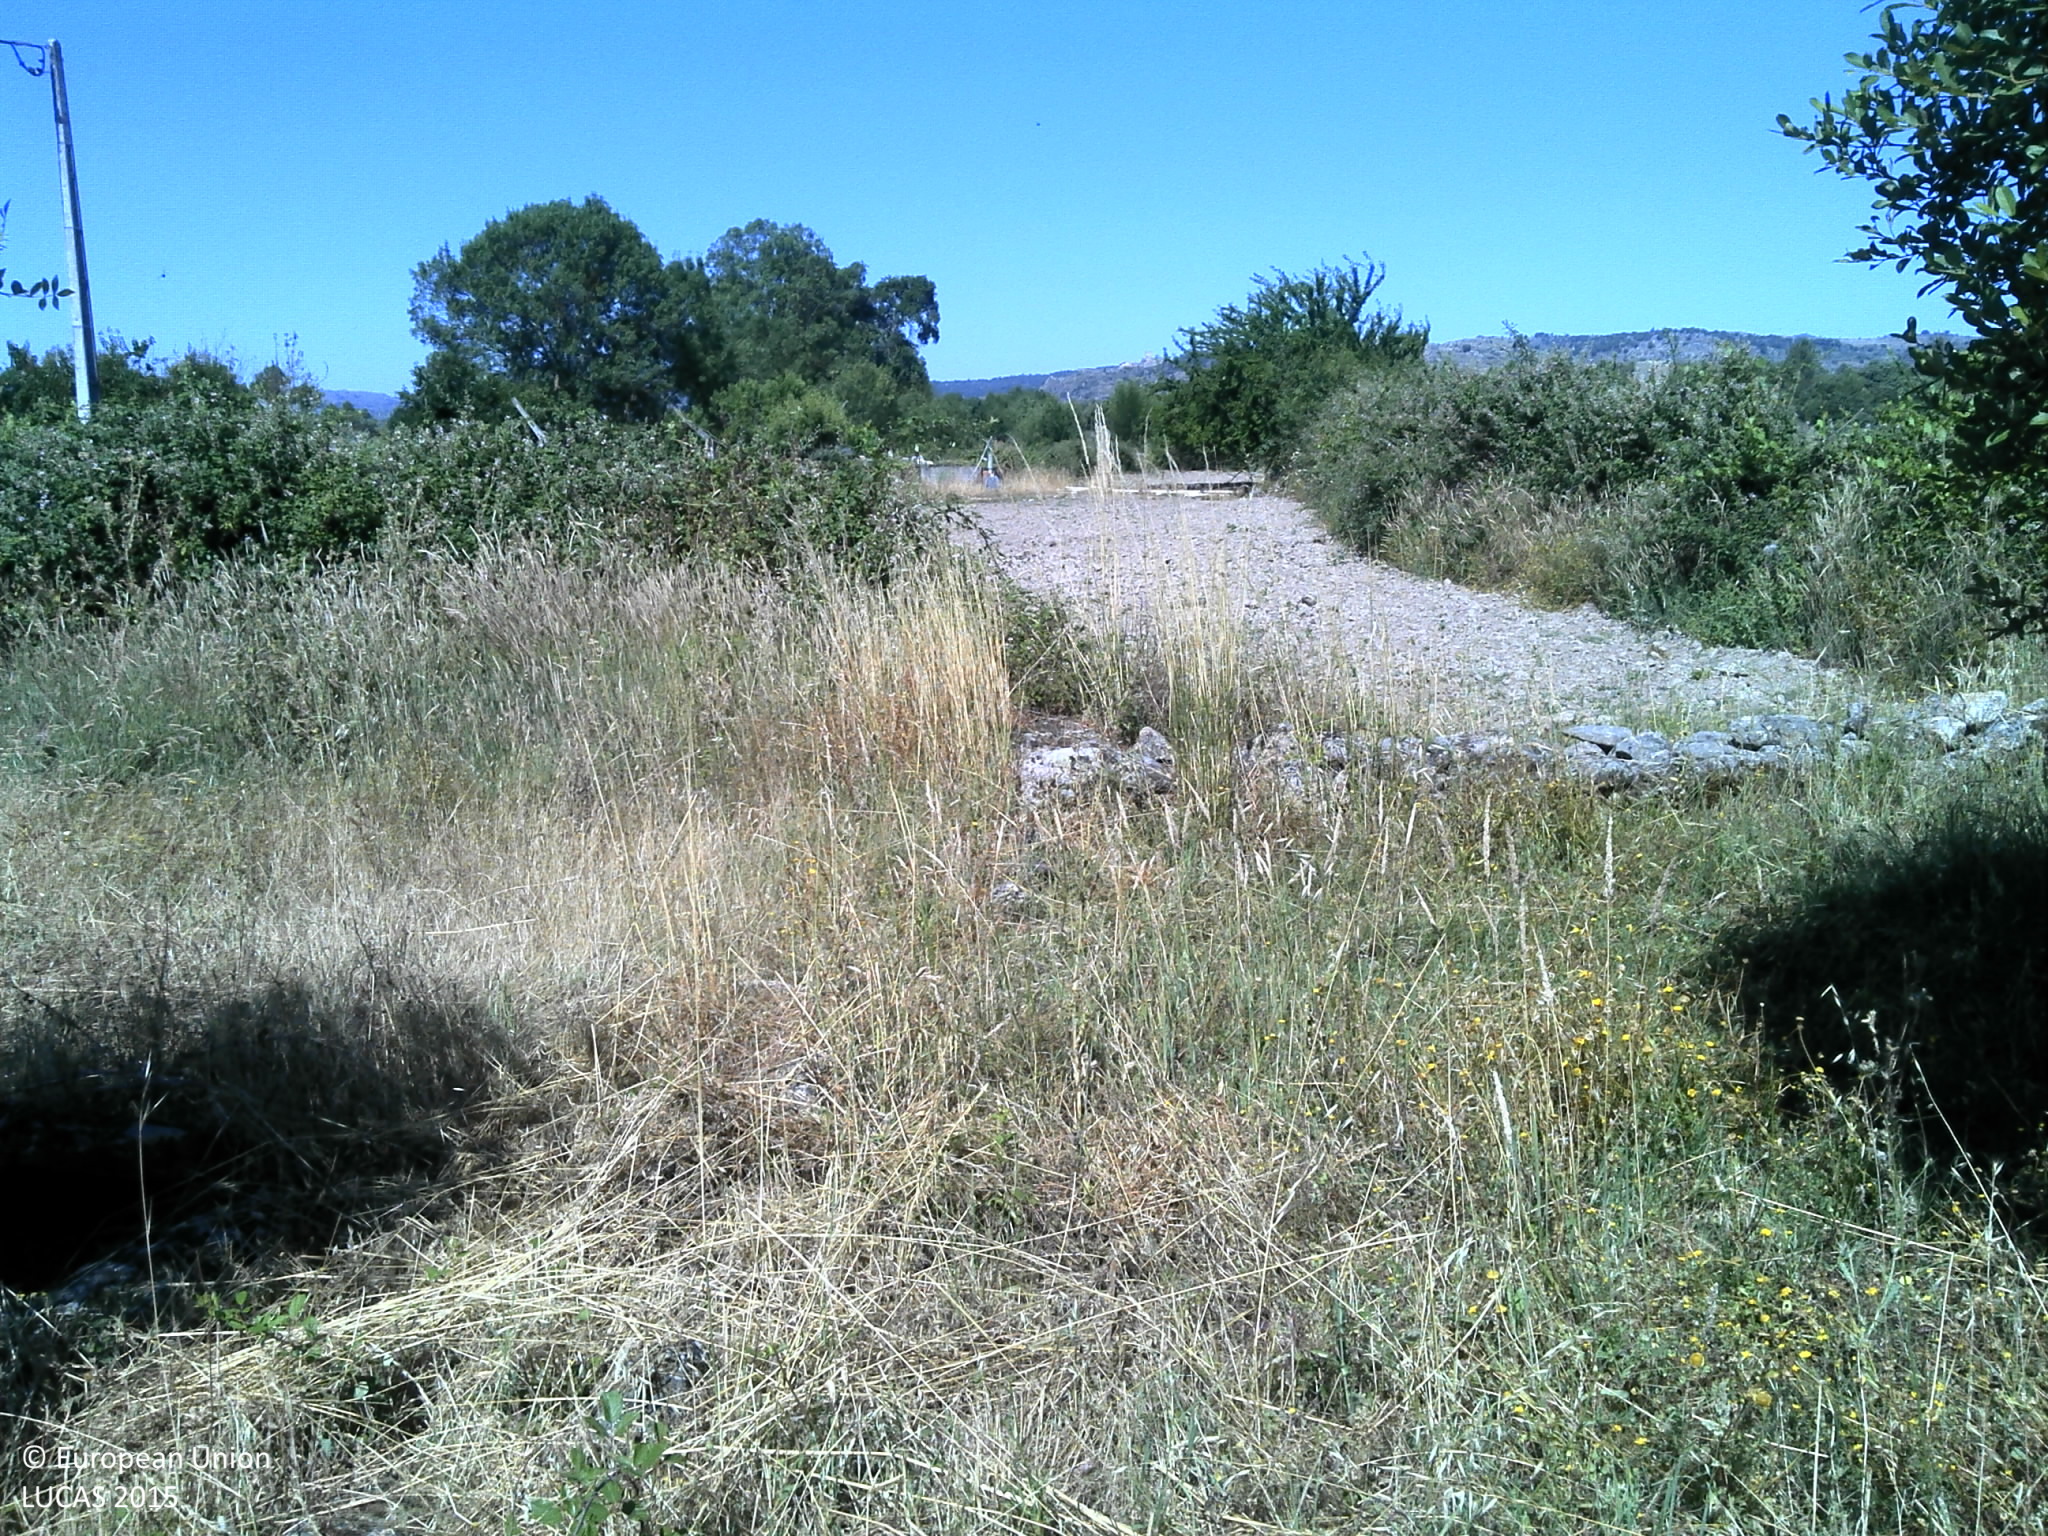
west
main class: Grassland
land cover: Grassland without tree/shrub cover
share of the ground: 50 - 75 %
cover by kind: herbaceous plants 65 %, unconsolidated bare surface 35 %
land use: Agriculture (excluding fallow land and kitchen gardens)
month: June
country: PT
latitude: 40.9124
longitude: -7.1951
